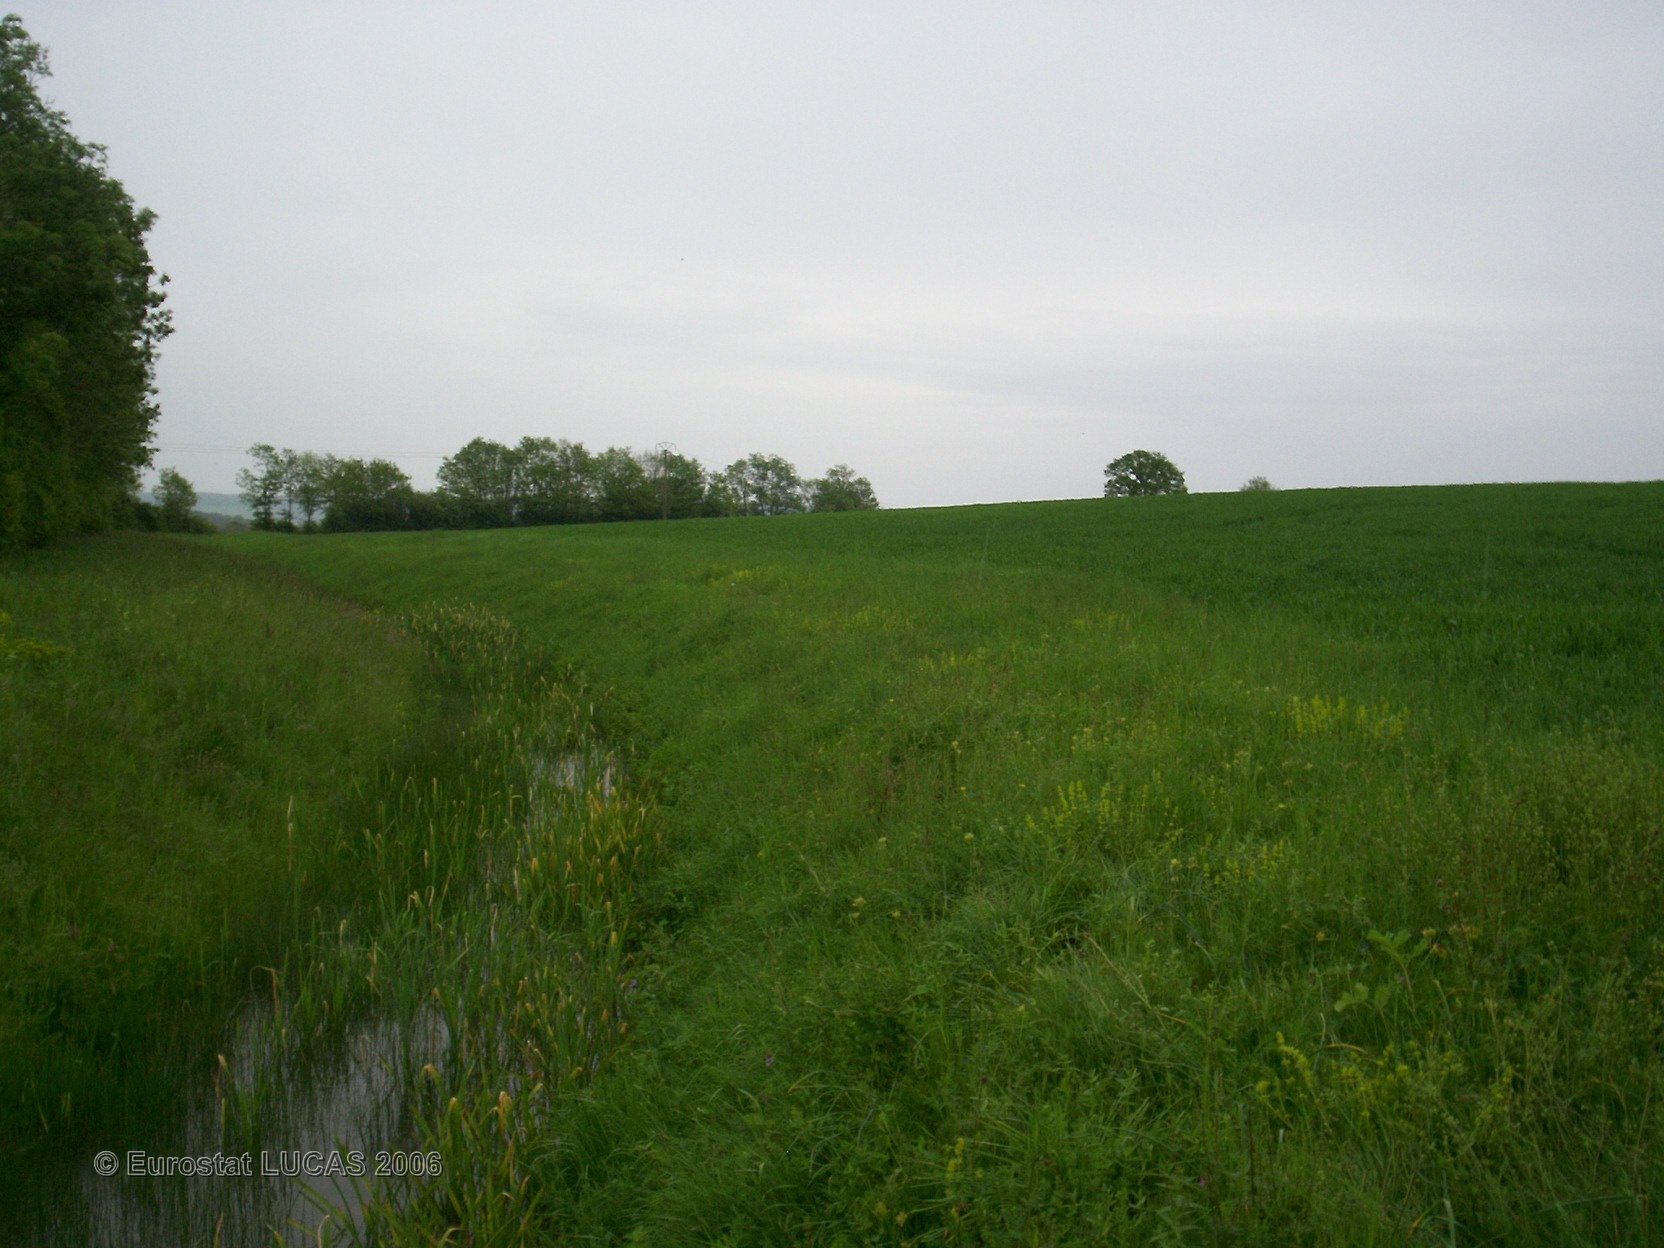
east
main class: Grassland
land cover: Grassland without tree/shrub cover
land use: Agriculture (excluding fallow land and kitchen gardens)
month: May
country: FR
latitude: 47.2420
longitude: 4.5702
